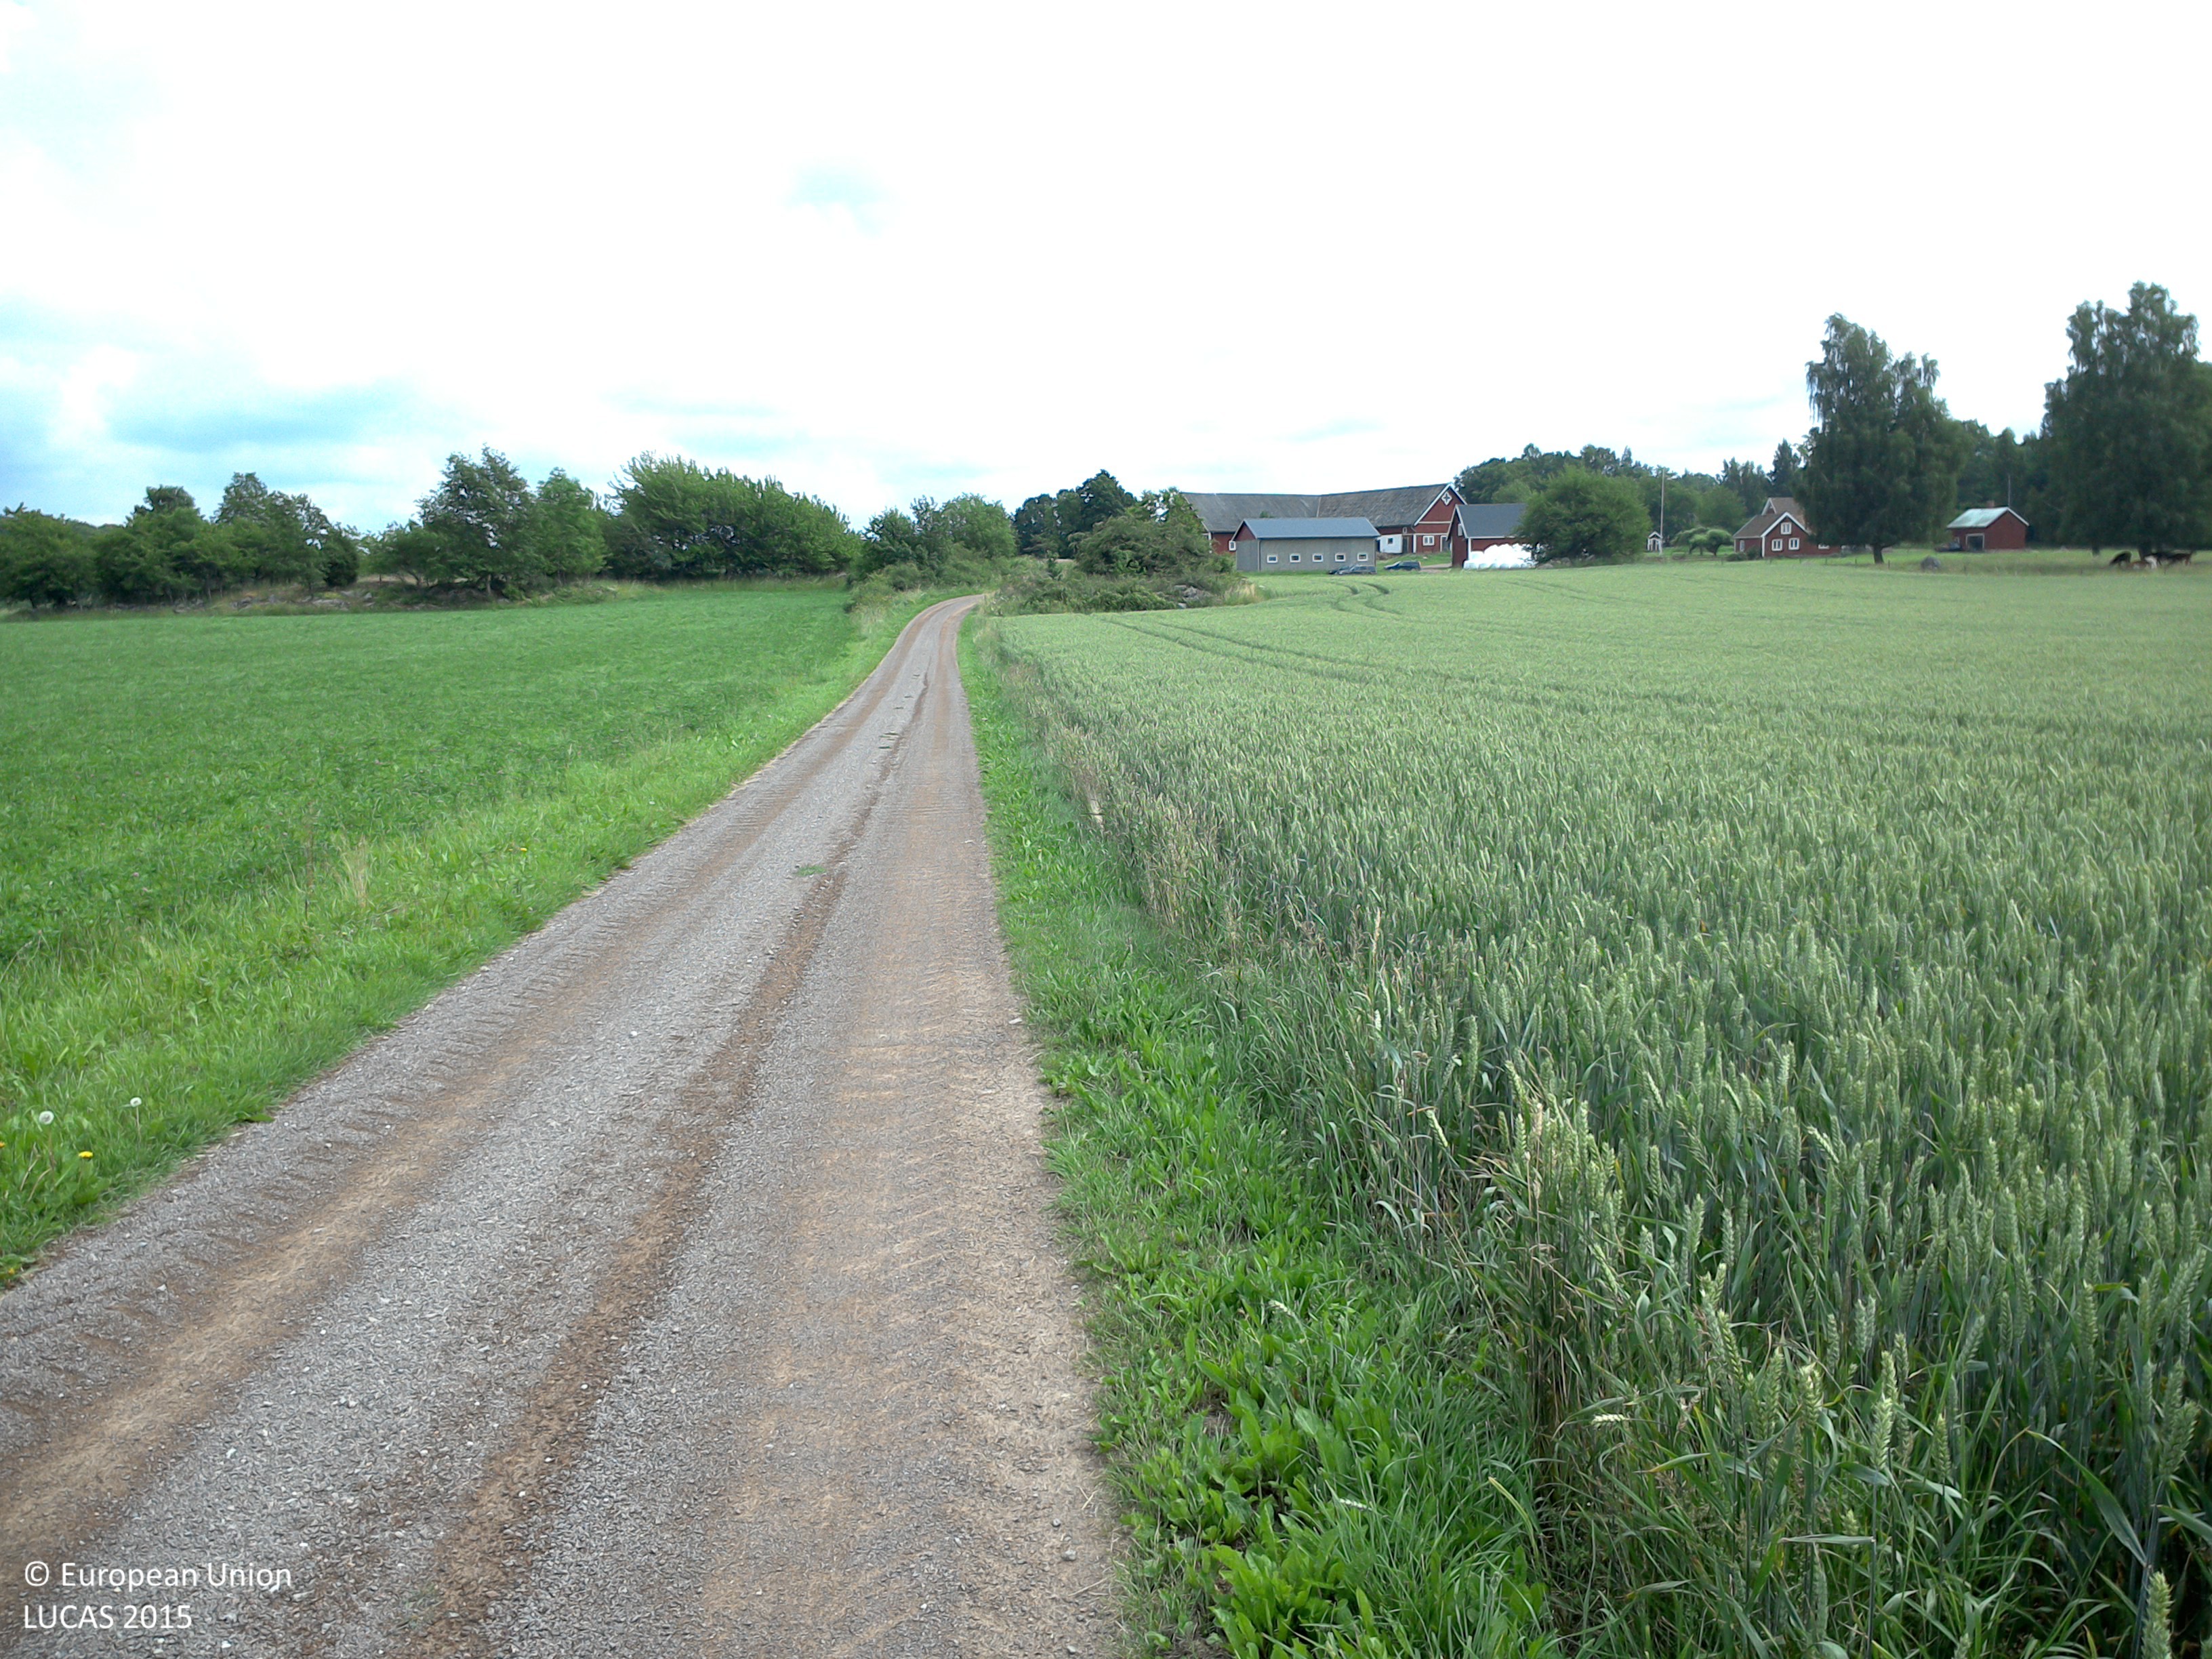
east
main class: Cropland
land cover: Common wheat
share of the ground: > 75 %
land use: Agriculture (excluding fallow land and kitchen gardens)
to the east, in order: Common wheat; Grass margins; Paved roads, cycling and walking lanes; Clovers; Fences; Grassland without tree/shrub cover
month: July
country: SE
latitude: 58.2630
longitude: 14.7154
